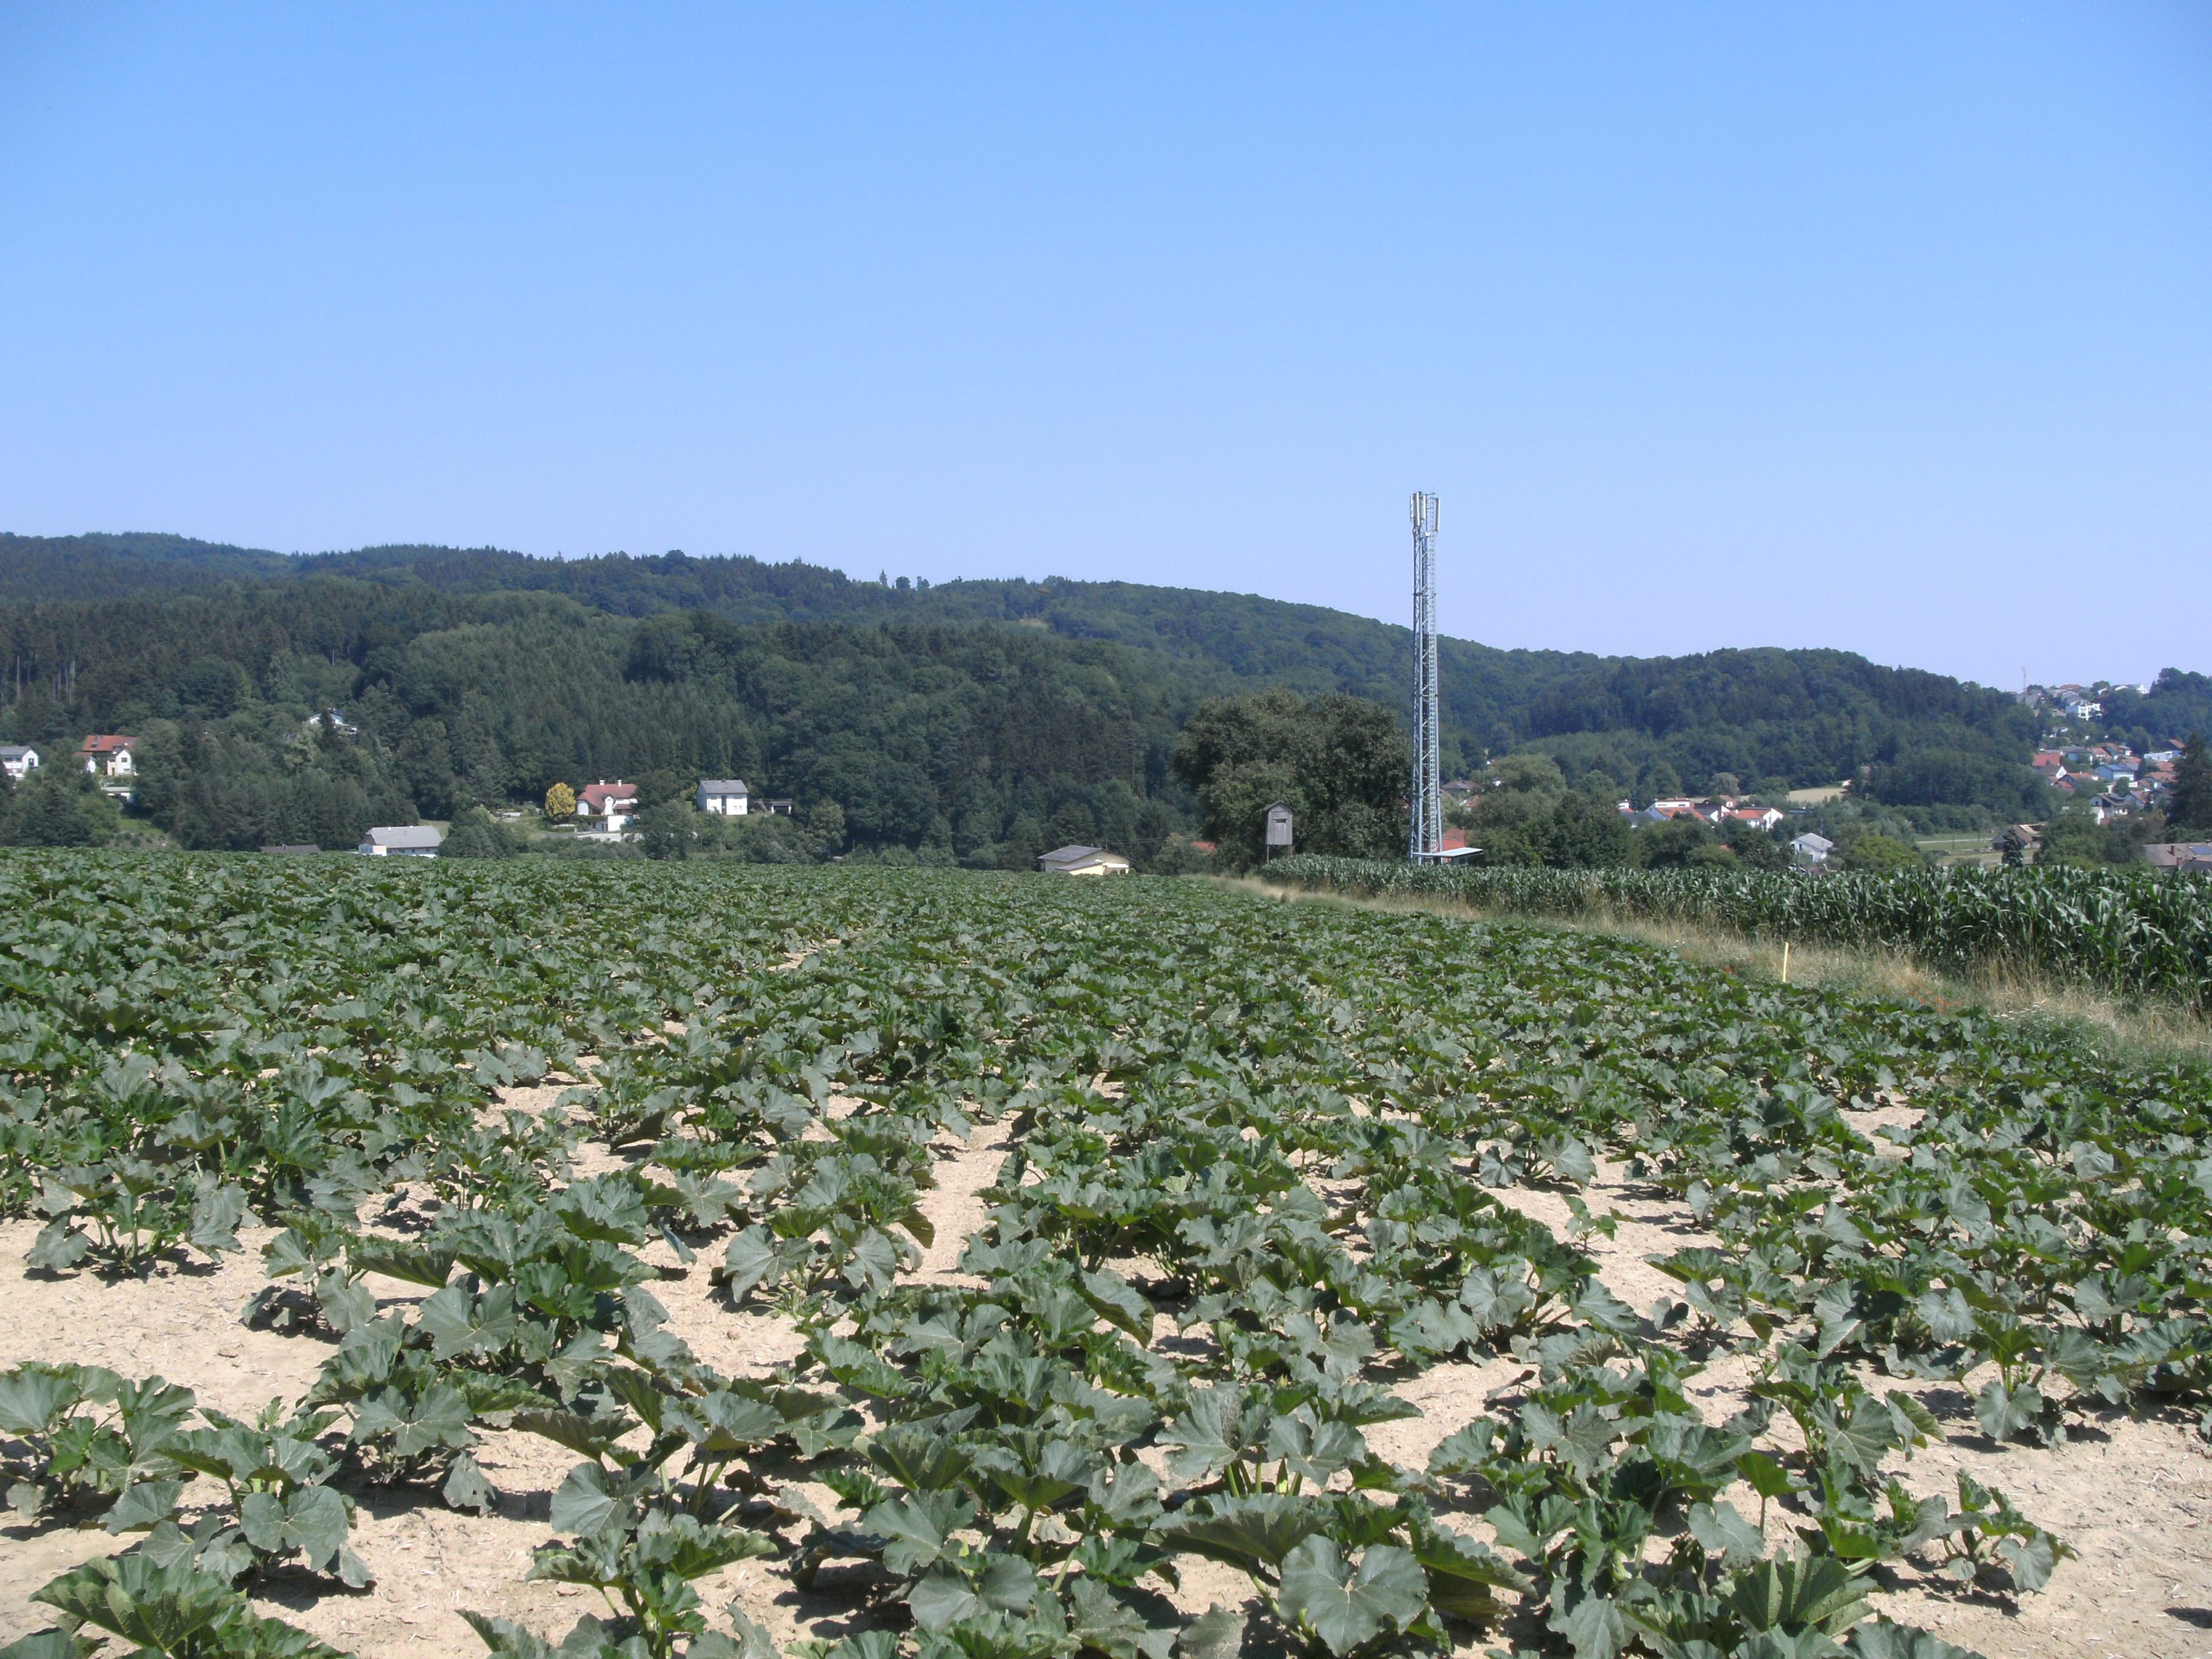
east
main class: Cropland
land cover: Other fresh vegetables
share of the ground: 50 - 75 %
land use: Agriculture (excluding fallow land and kitchen gardens)
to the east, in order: Other fresh vegetables; Grass margins; Tracks; Grass margins; Maize
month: July
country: AT
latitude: 48.2880
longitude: 14.1915
